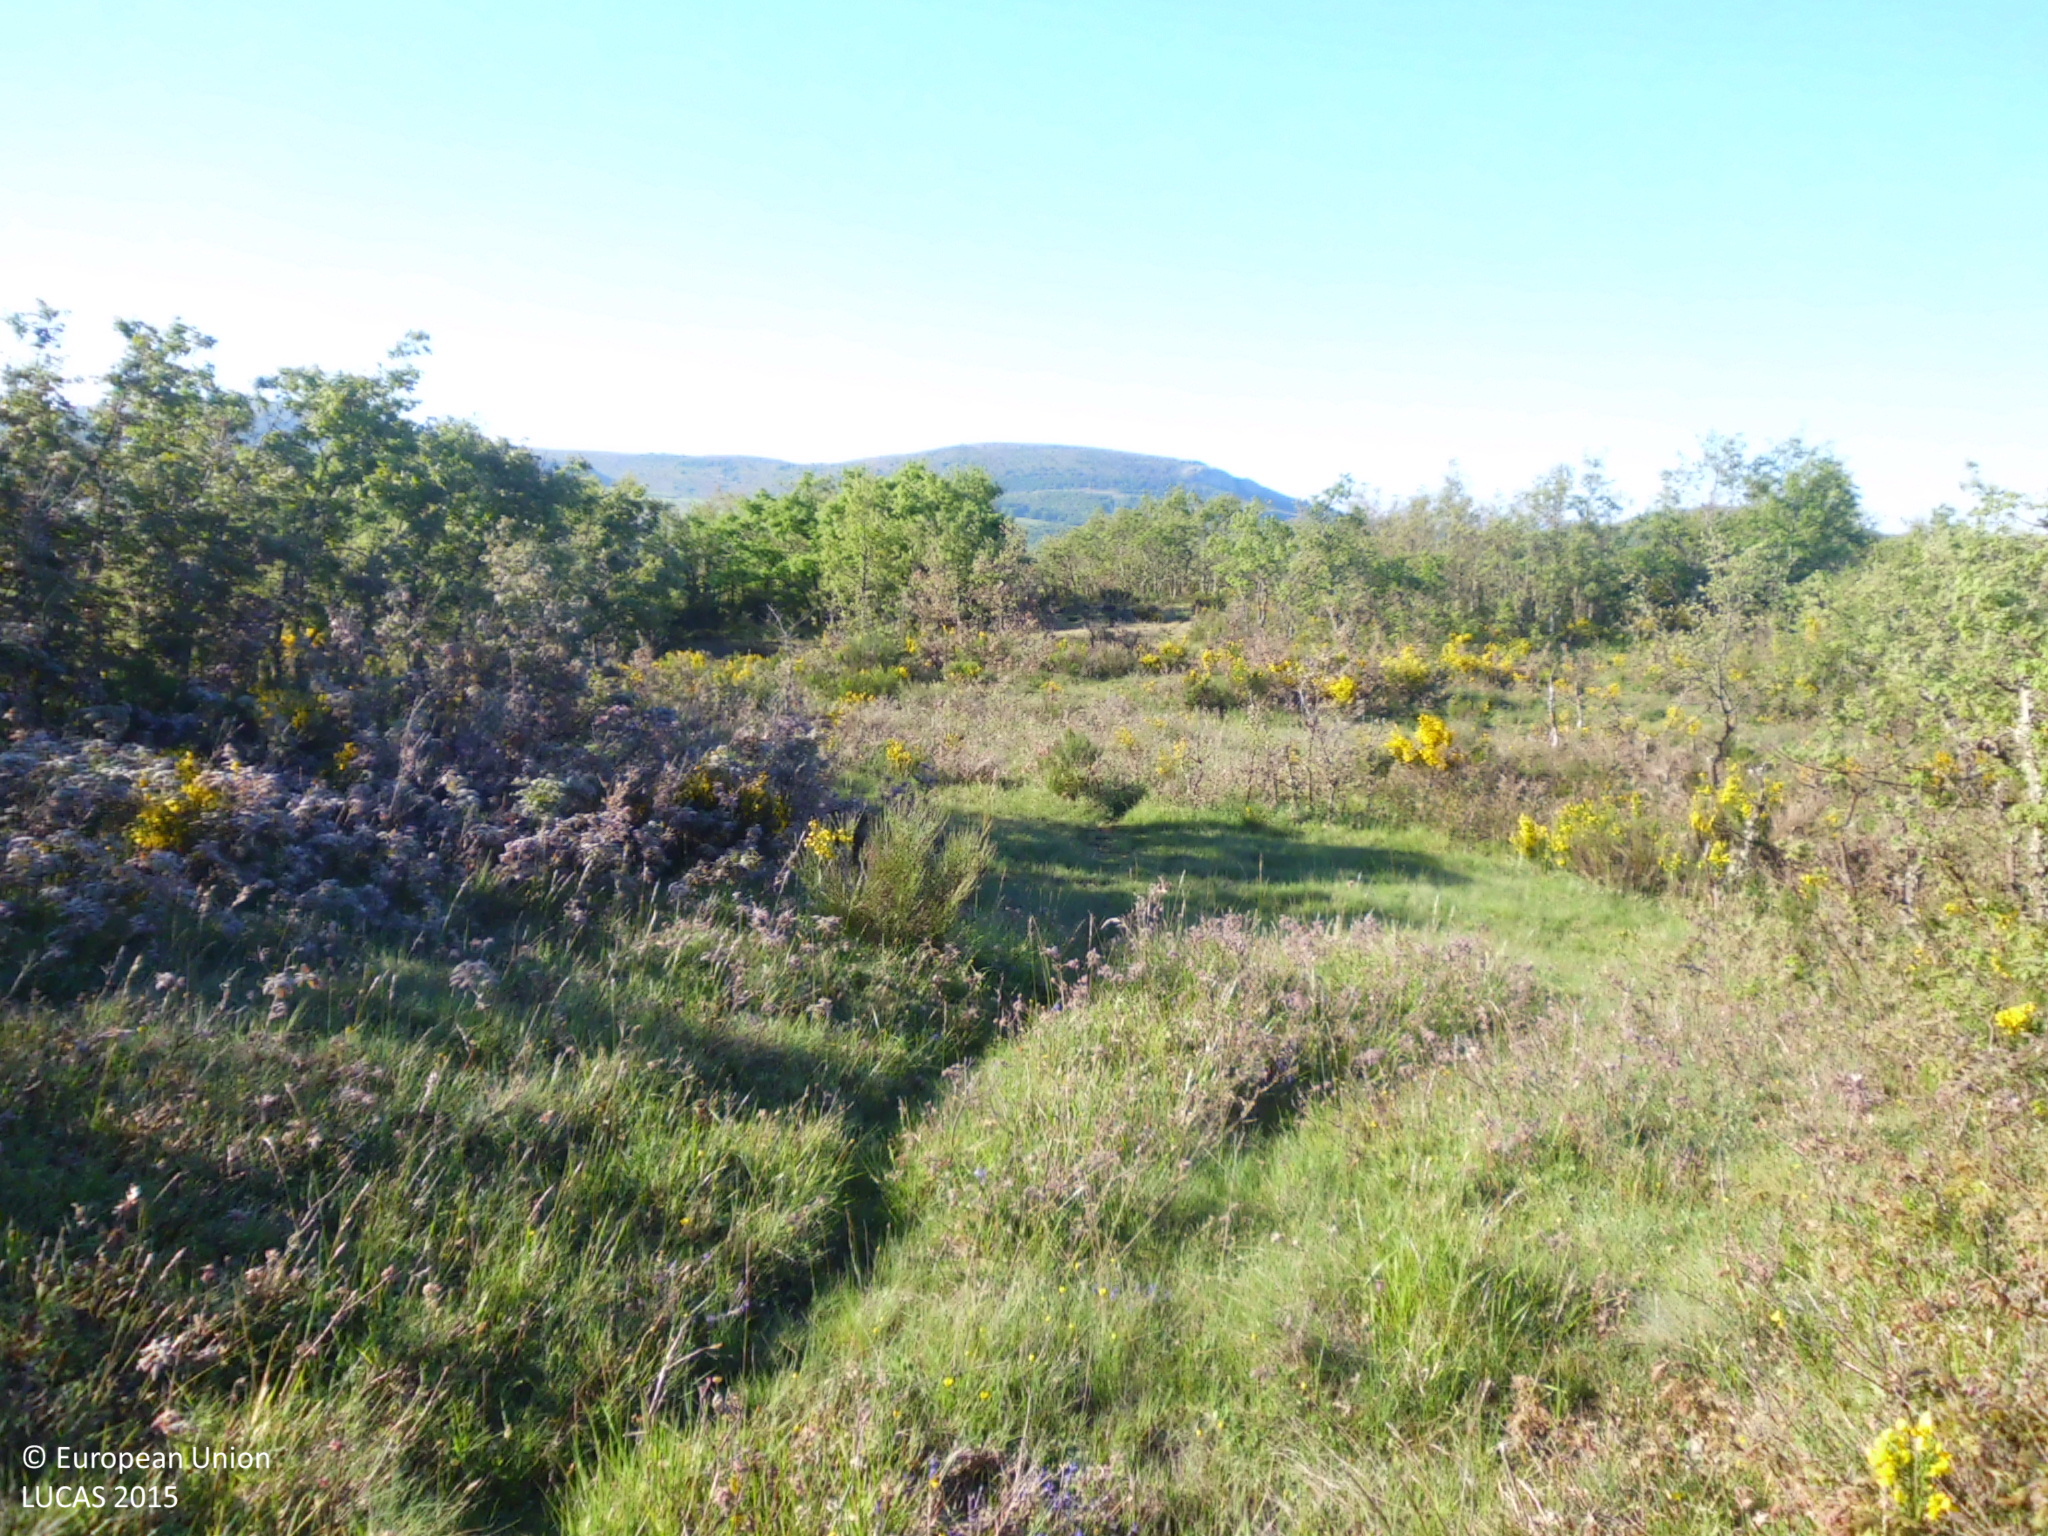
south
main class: Woodland
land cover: Broadleaved woodland
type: acidophilous oak and oak-birch forest
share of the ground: > 75 %
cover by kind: broadleaved forest trees 75 %, herbaceous plants 15 %, shrubs 10 %
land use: Semi-natural and natural areas not in use
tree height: < 5 m
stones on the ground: 25 - 50 %
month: May
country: ES
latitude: 42.8700
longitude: -4.4869
